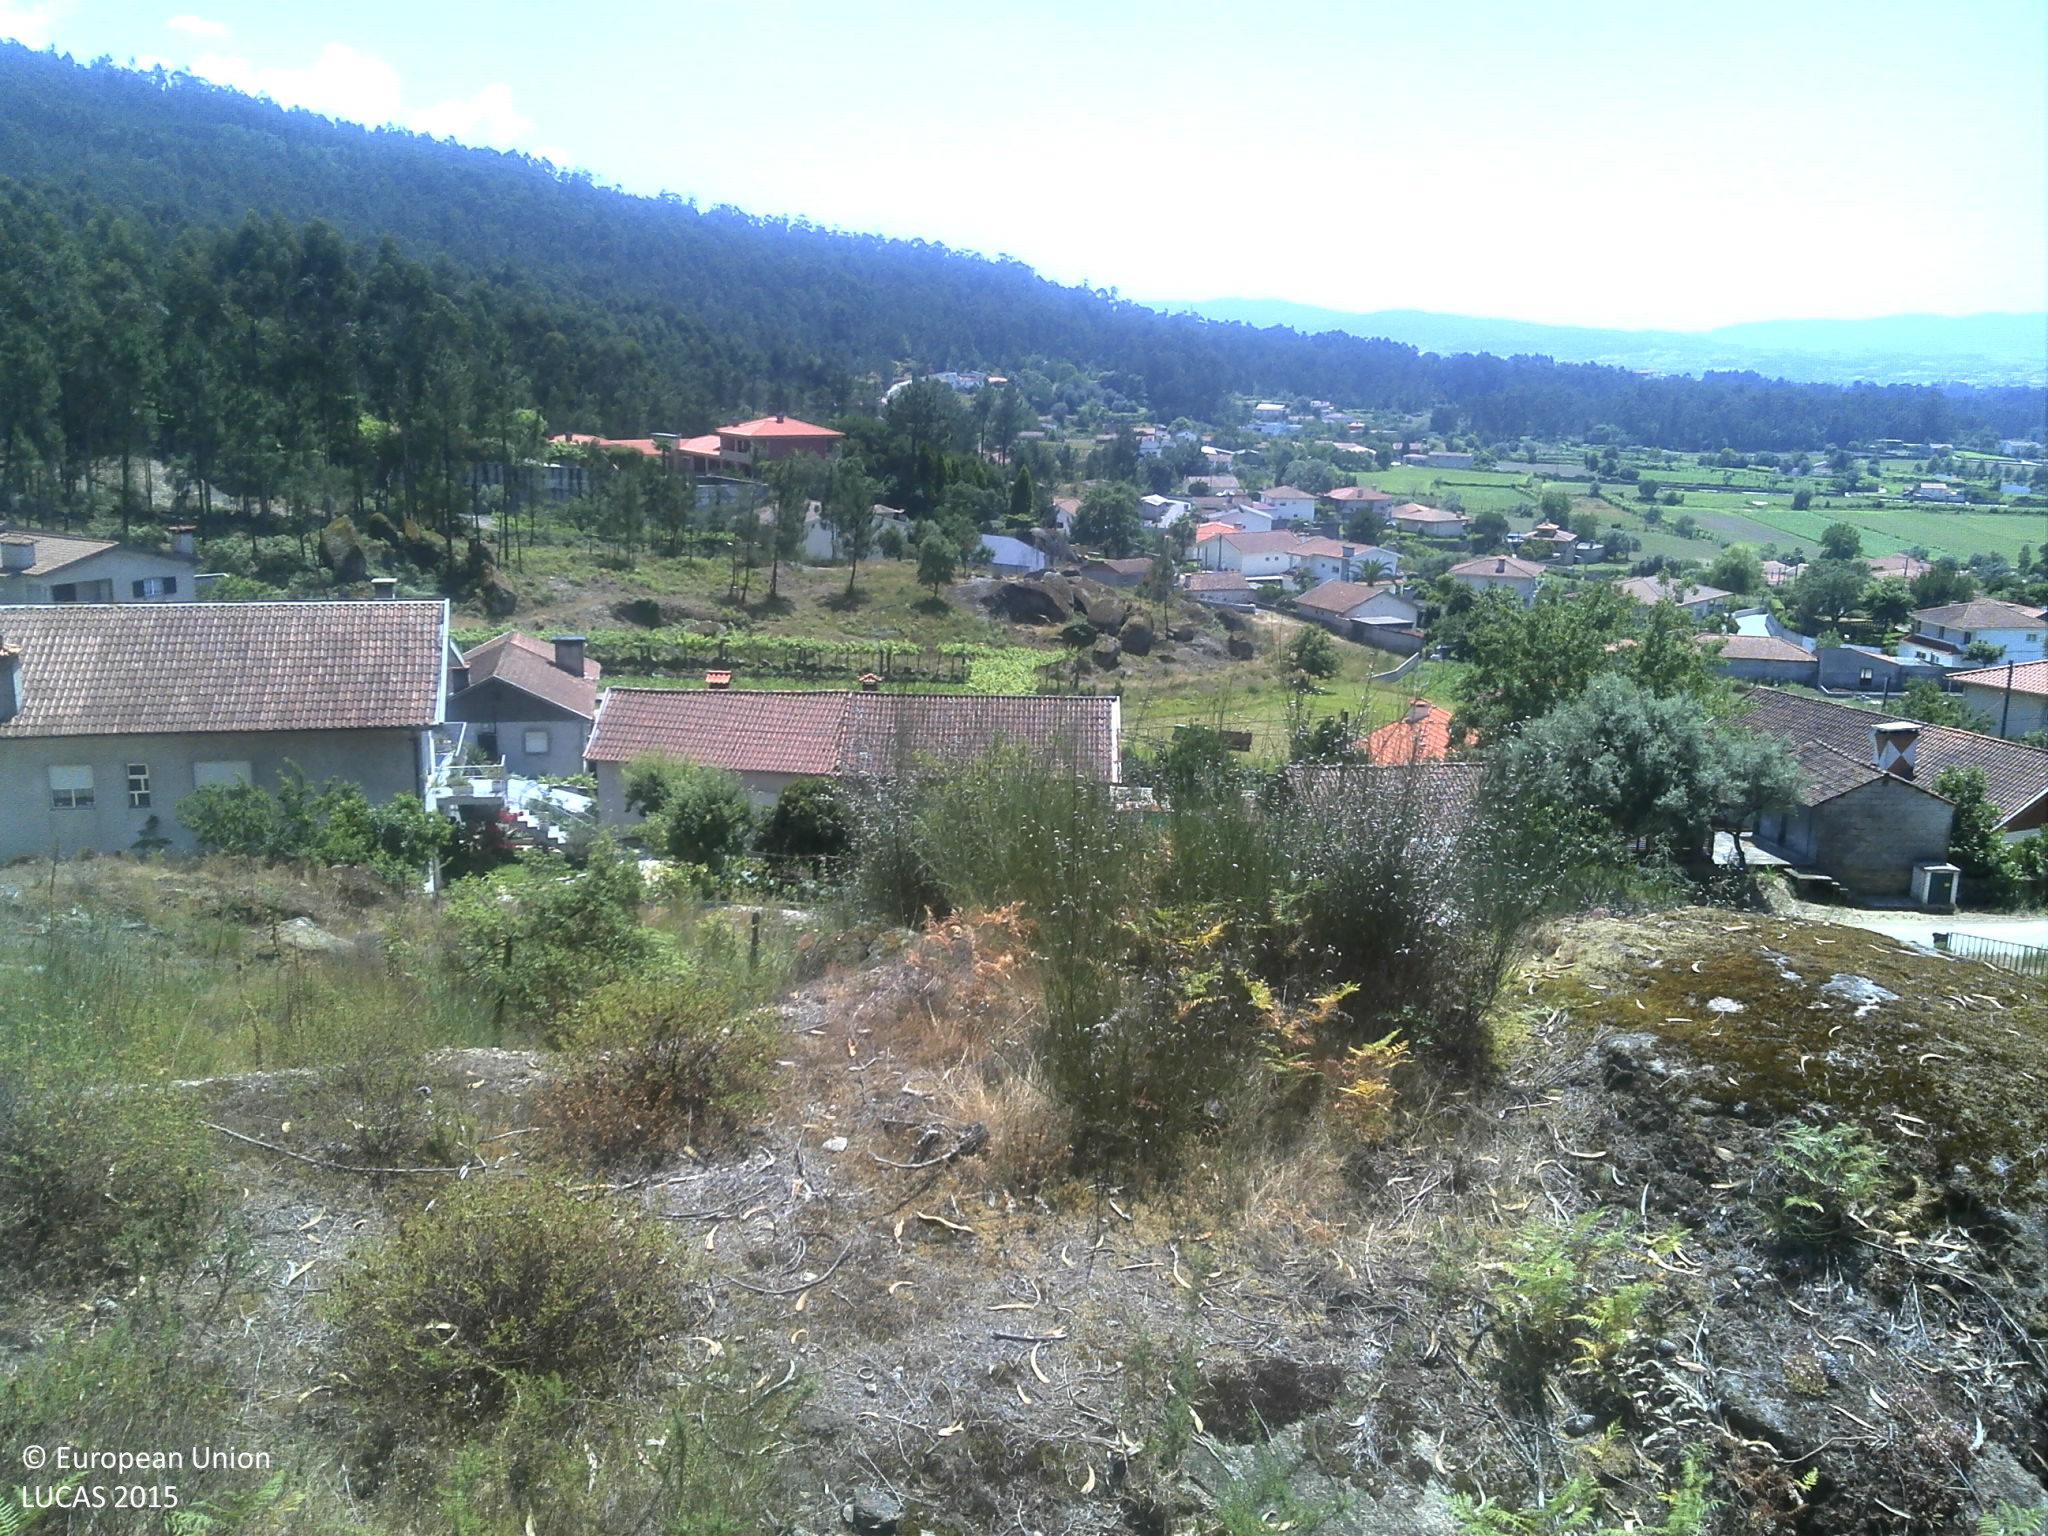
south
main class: Shrubland
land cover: Shrubland with sparse tree cover
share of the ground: 50 - 75 %
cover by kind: shrubs 60 %, unconsolidated bare surface 25 %, consolidated bare surface 10 %, broadleaved forest trees 5 %
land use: Forestry
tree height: < 5 m
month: June
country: PT
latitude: 41.5840
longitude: -8.5711
